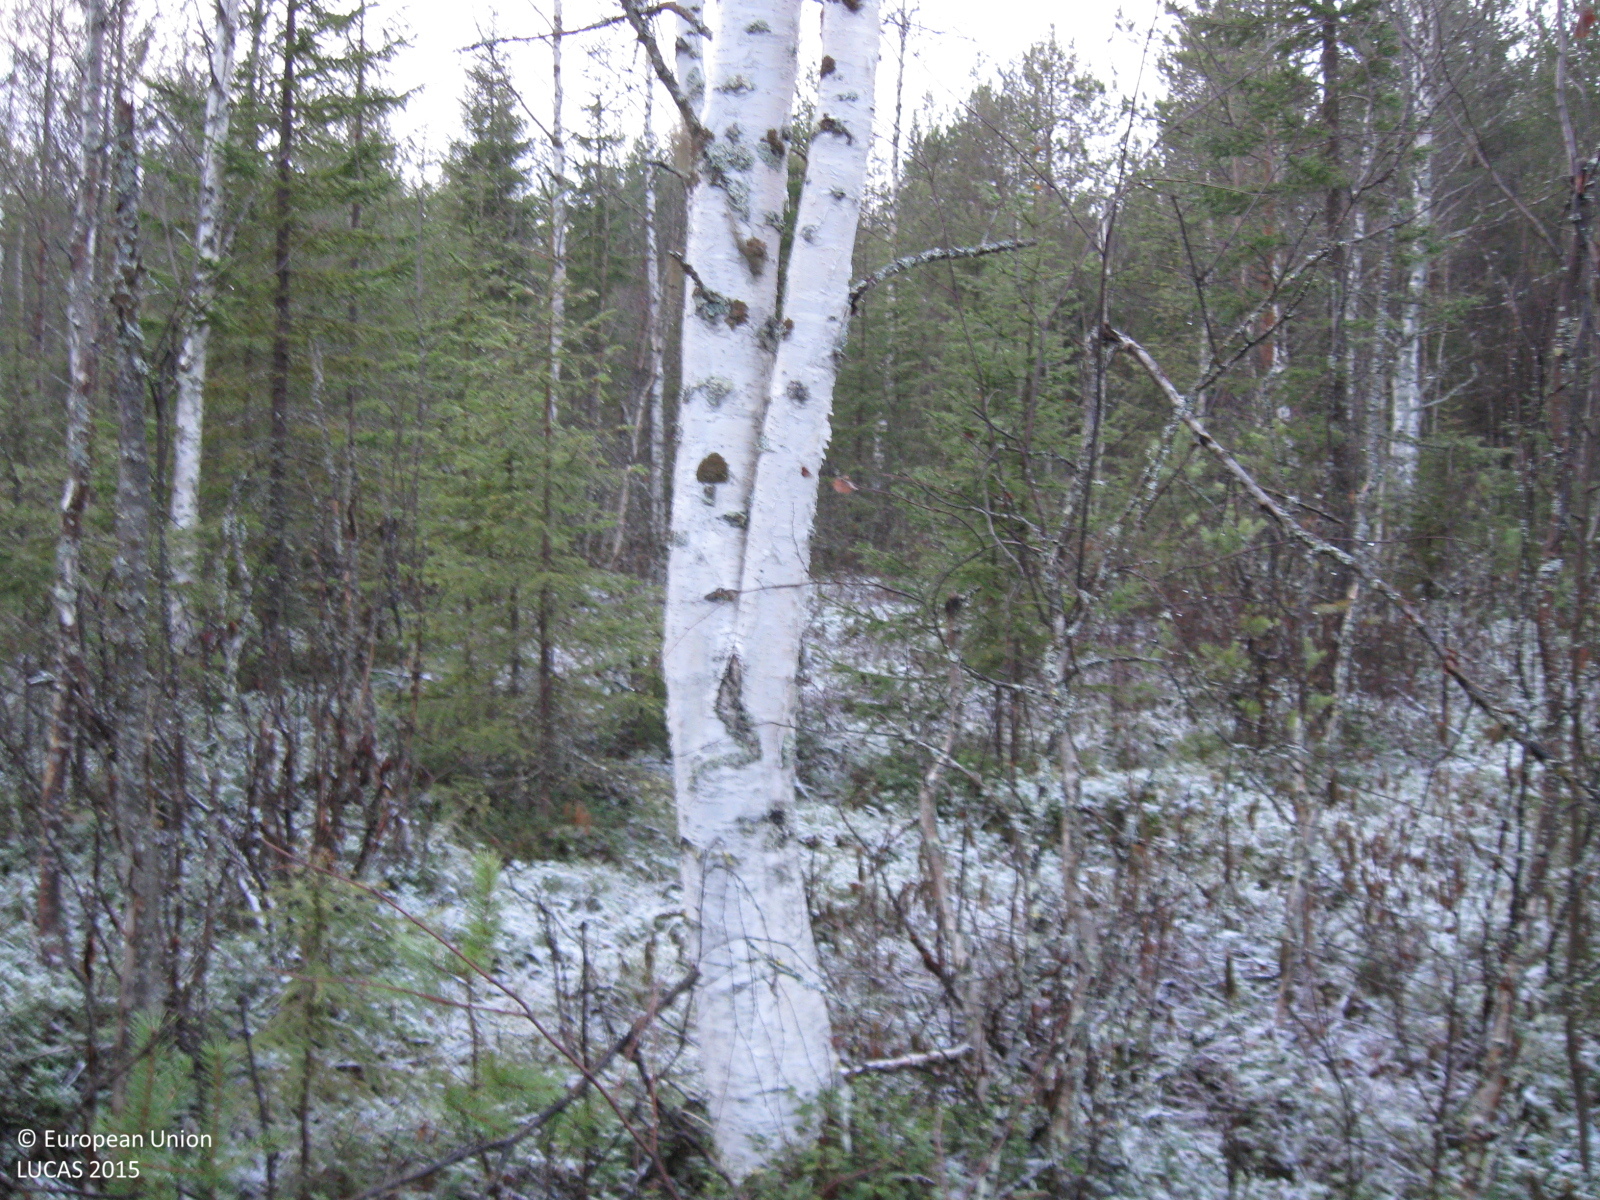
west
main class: Woodland
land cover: Spruce dominated mixed woodland
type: boreal forest
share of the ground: > 75 %
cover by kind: broadleaved forest trees 55 %, coniferous forest trees 20 %, shrubs 10 %, herbaceous plants 10 %, lichens and mosses 5 %
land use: Forestry
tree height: > 5 m
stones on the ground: < 10 %
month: October
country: SE
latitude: 66.2203
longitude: 20.8293
